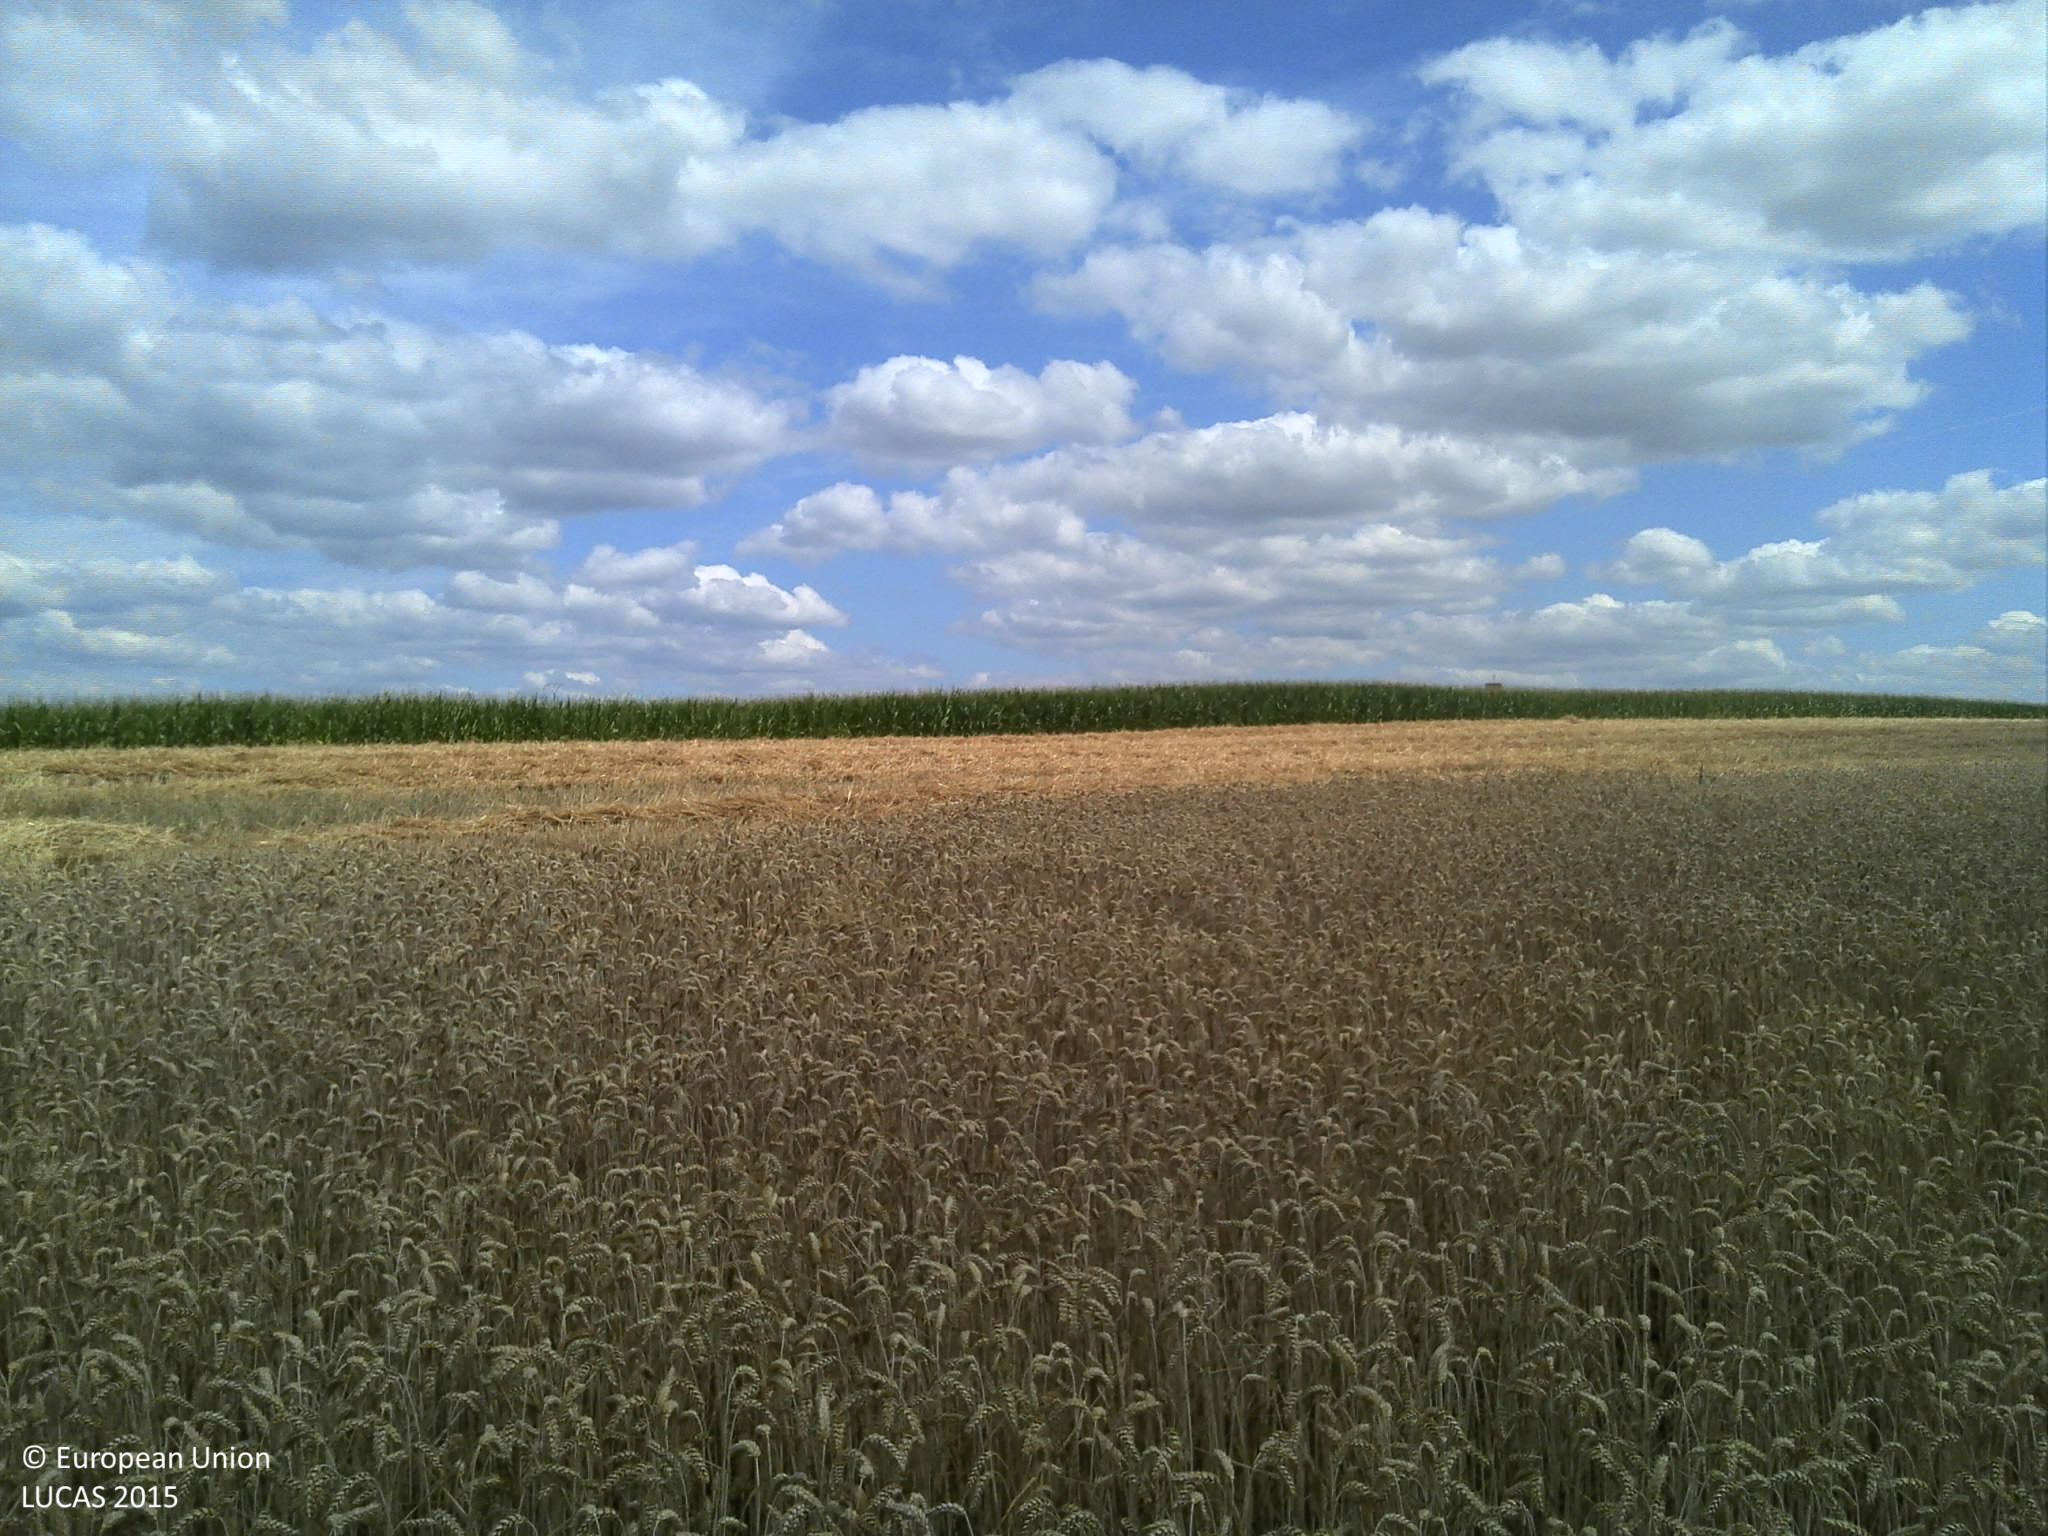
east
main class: Cropland
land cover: Maize
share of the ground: > 75 %
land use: Agriculture (excluding fallow land and kitchen gardens)
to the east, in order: Maize; Electric lines; Maize
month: July
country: FR
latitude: 49.5831
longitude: 4.5051
